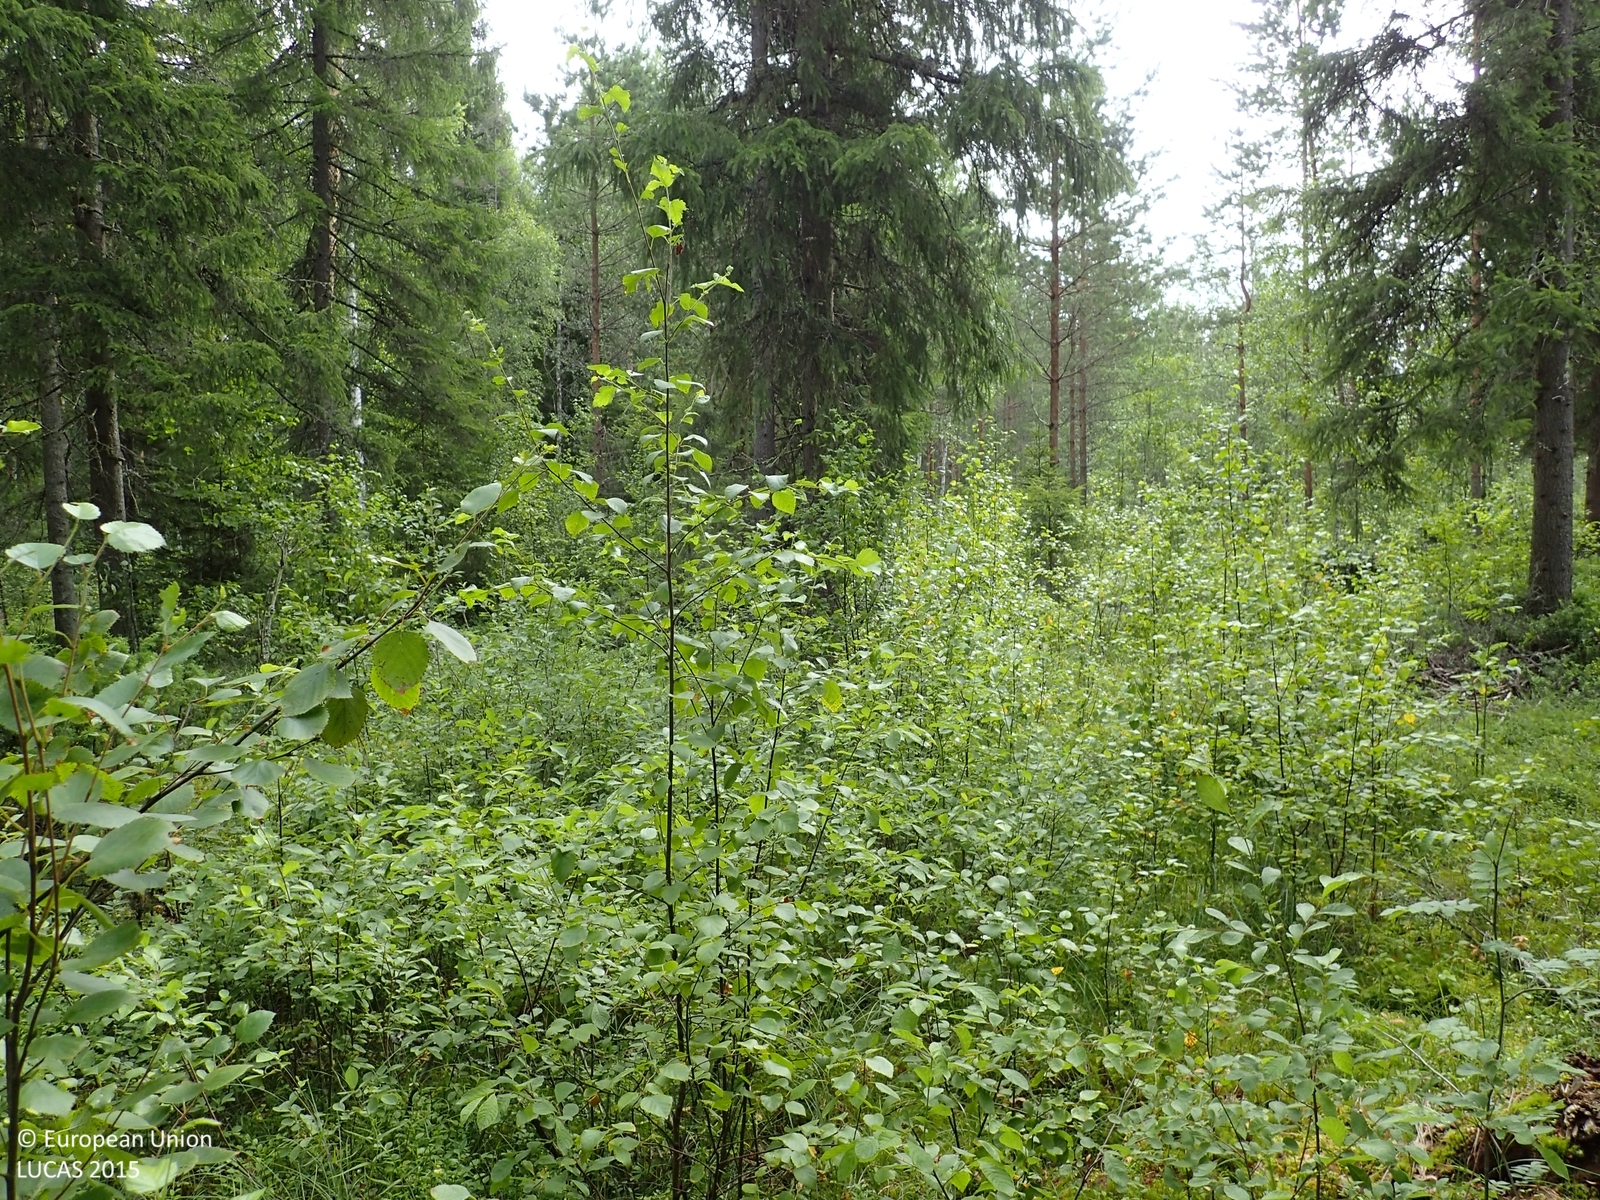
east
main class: Woodland
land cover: Spruce dominated mixed woodland
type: boreal forest
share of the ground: > 75 %
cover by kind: coniferous forest trees 55 %, broadleaved forest trees 20 %, shrubs 20 %, herbaceous plants 5 %
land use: Forestry
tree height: > 5 m
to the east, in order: Spruce dominated mixed woodland; Ditches and canals; Other mixed woodland; Ditches and canals; Other mixed woodland; Ditches and canals; Other coniferous woodland
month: July
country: FI
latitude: 62.8889
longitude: 22.3436
